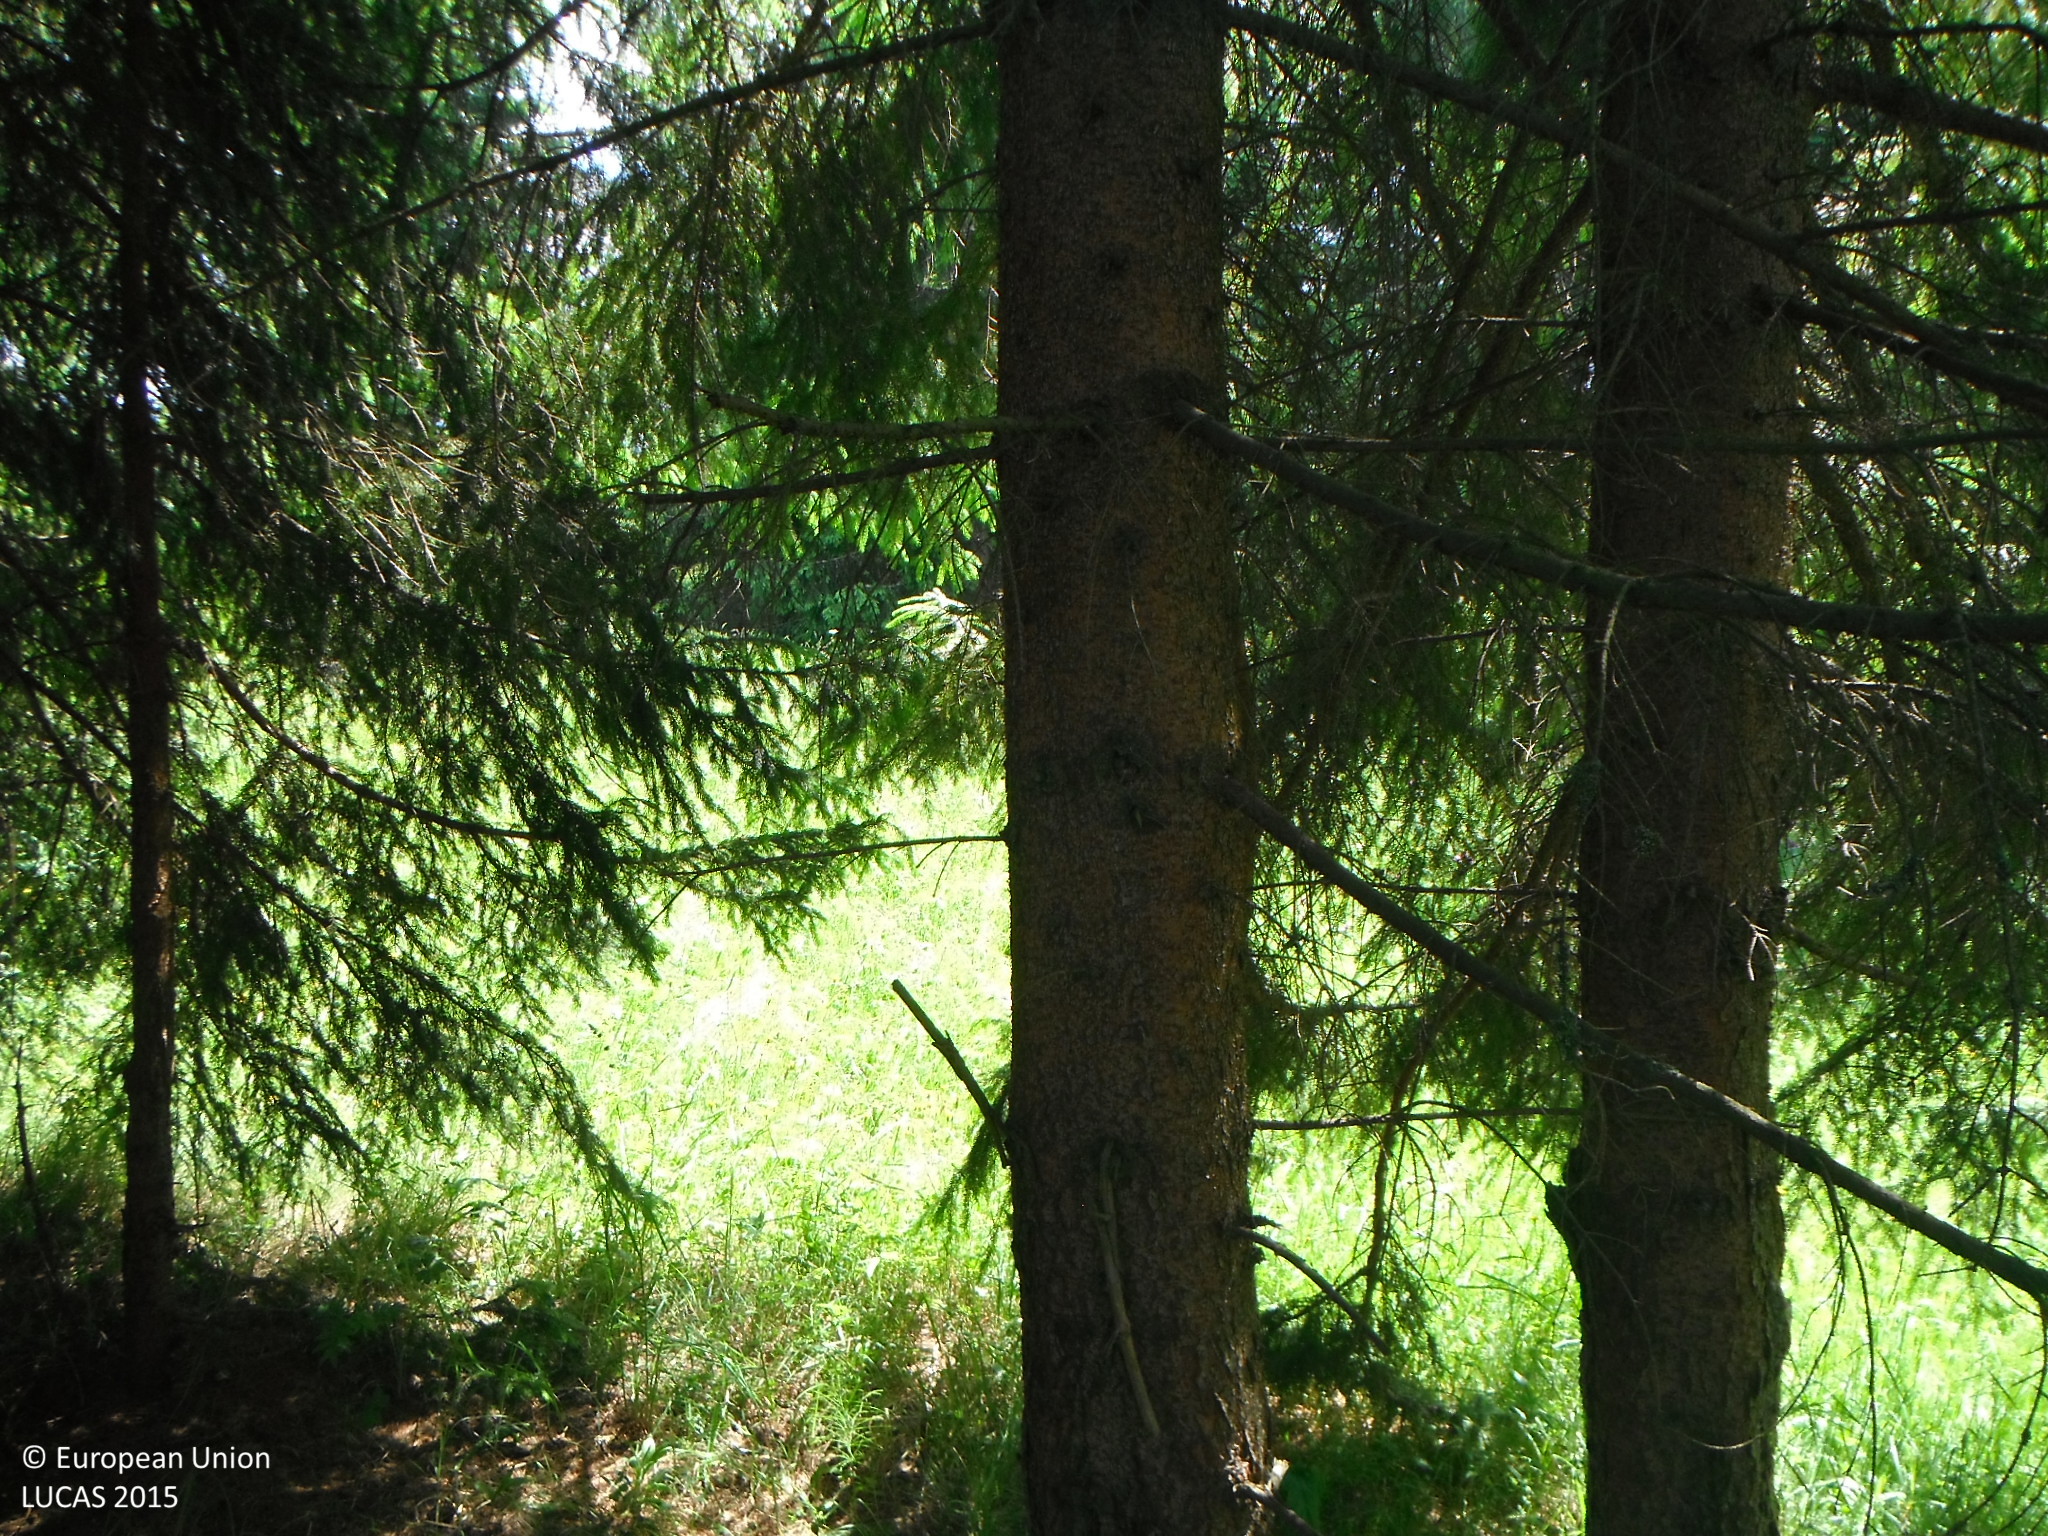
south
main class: Woodland
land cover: Spruce dominated coniferous woodland
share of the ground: > 75 %
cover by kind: coniferous forest trees 80 %, herbaceous plants 10 %, lichens and mosses 5 %, unconsolidated bare surface 5 %
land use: Forestry
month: July
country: SK
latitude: 49.3808
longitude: 19.1559
